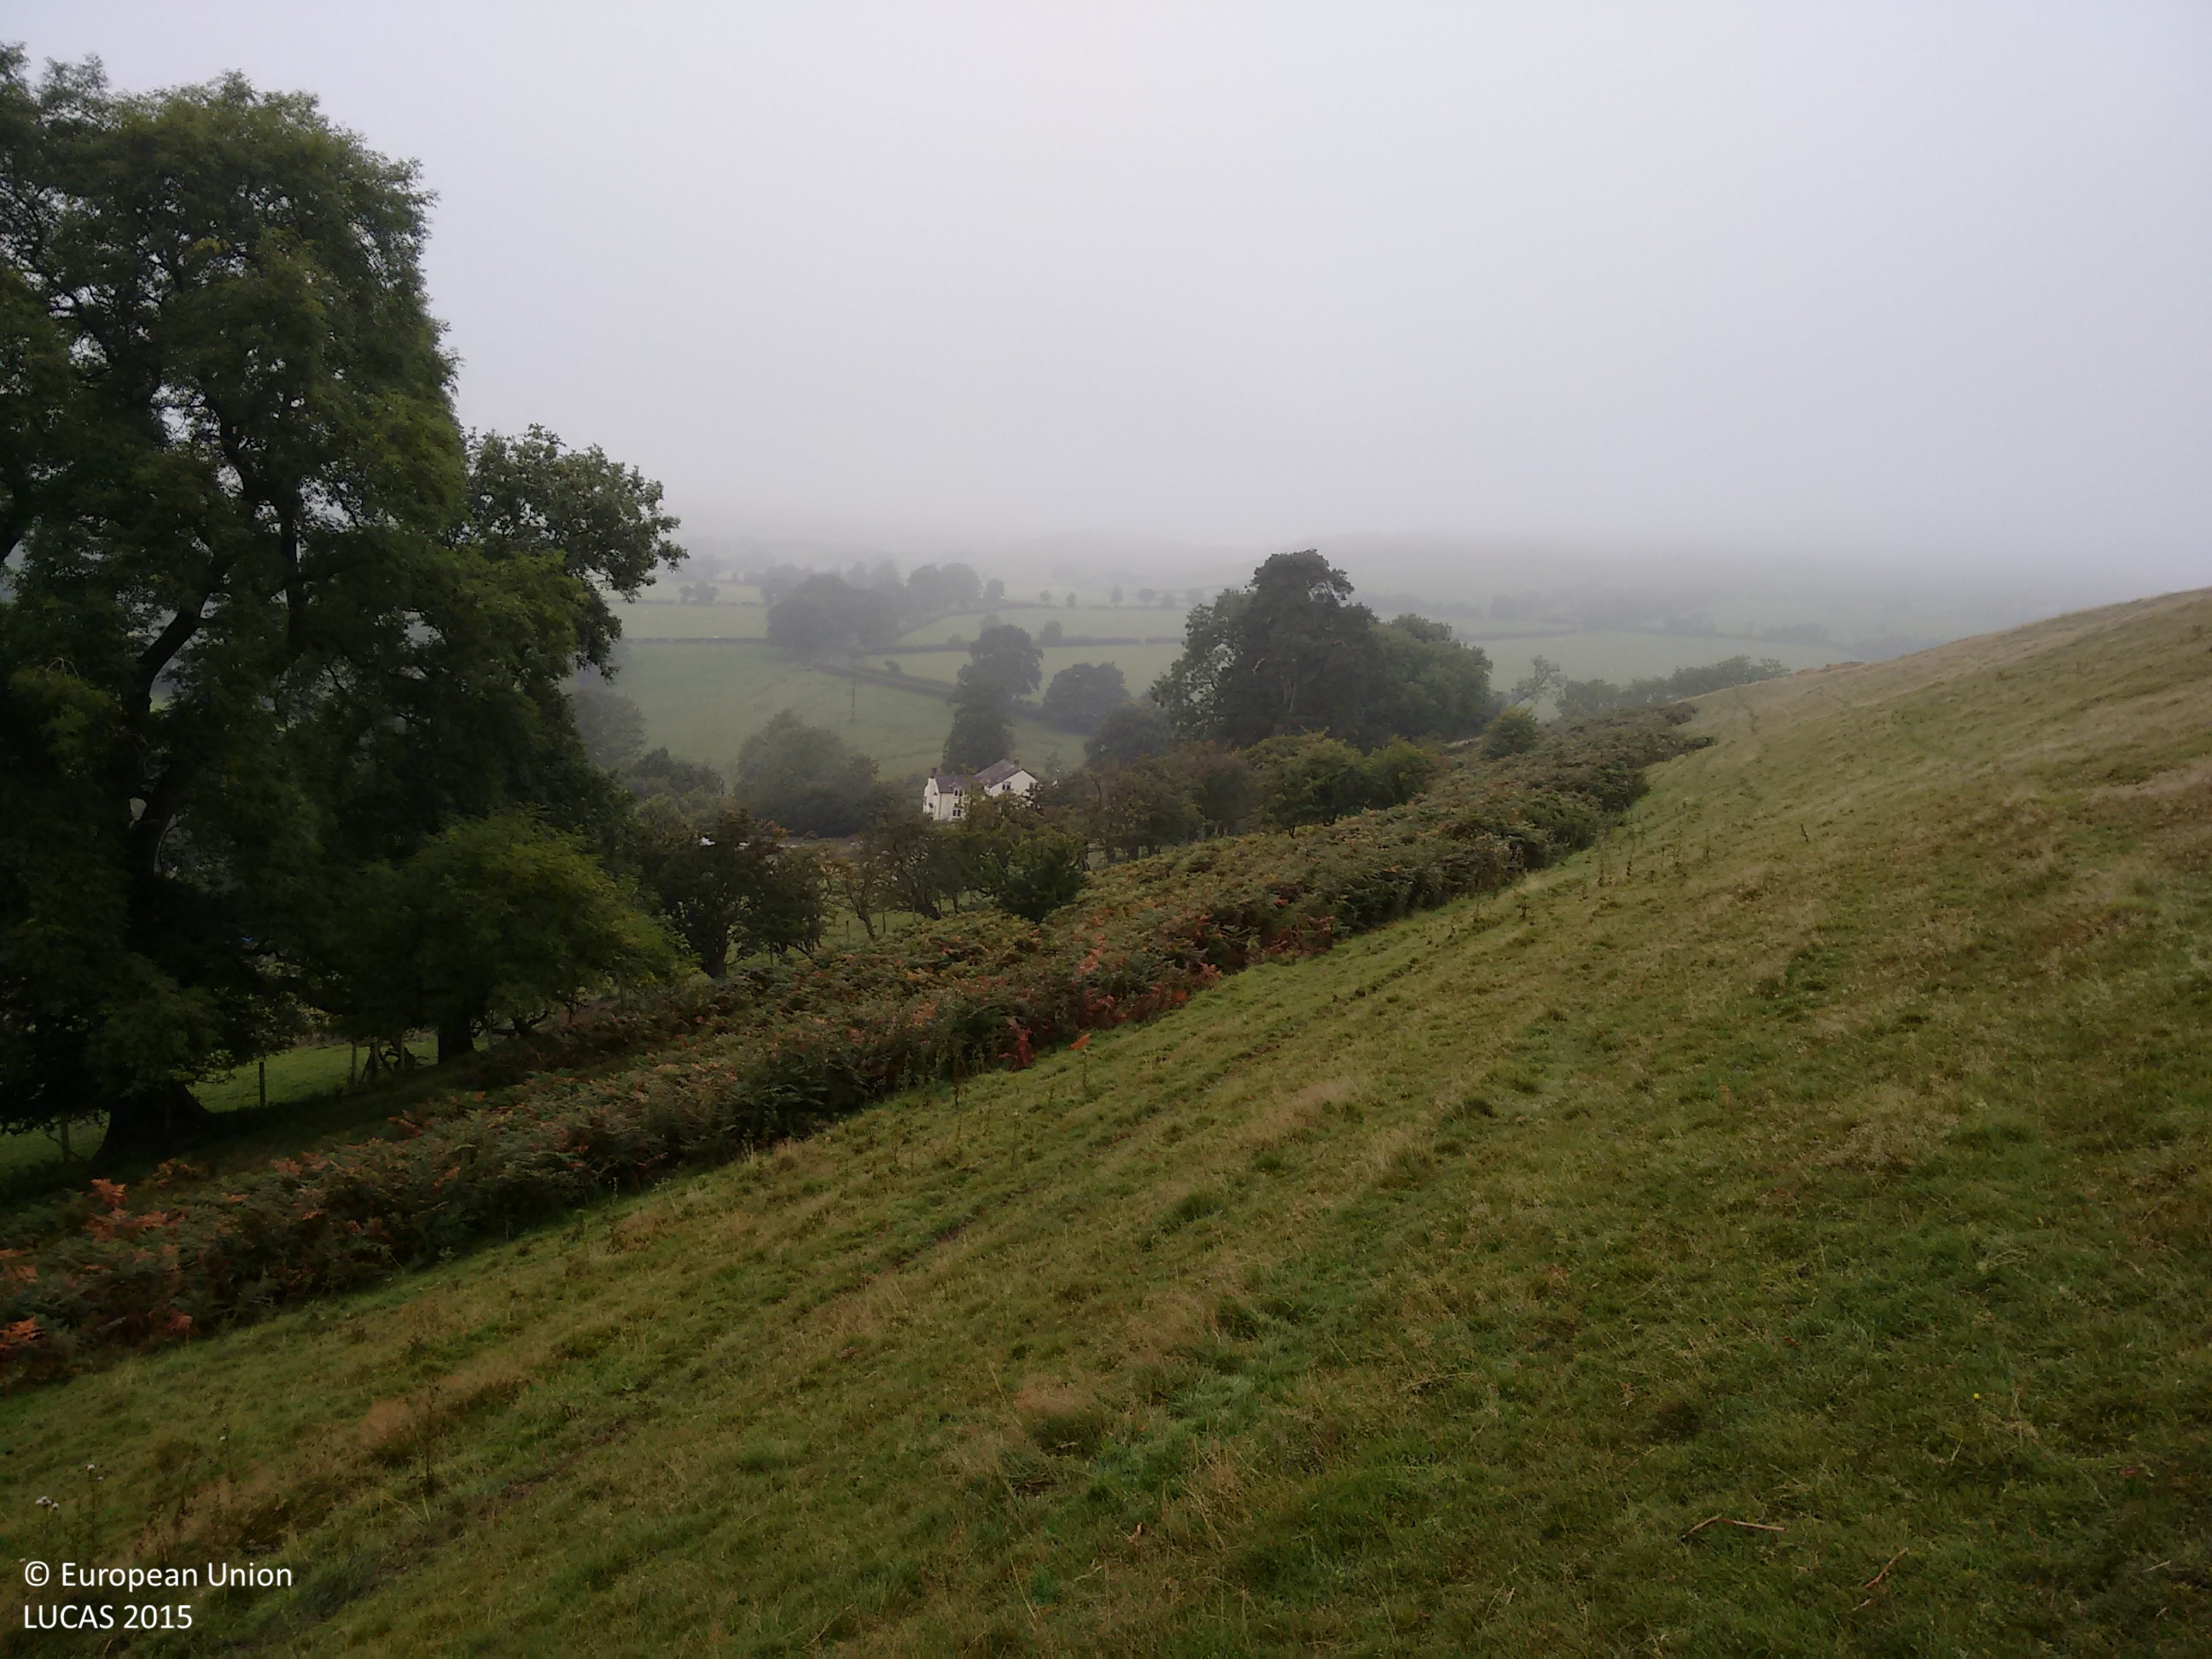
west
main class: Grassland
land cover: Grassland without tree/shrub cover
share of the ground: > 75 %
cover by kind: herbaceous plants 100 %
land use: Agriculture (excluding fallow land and kitchen gardens)
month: September
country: GB
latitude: 52.5633
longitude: -2.8925
